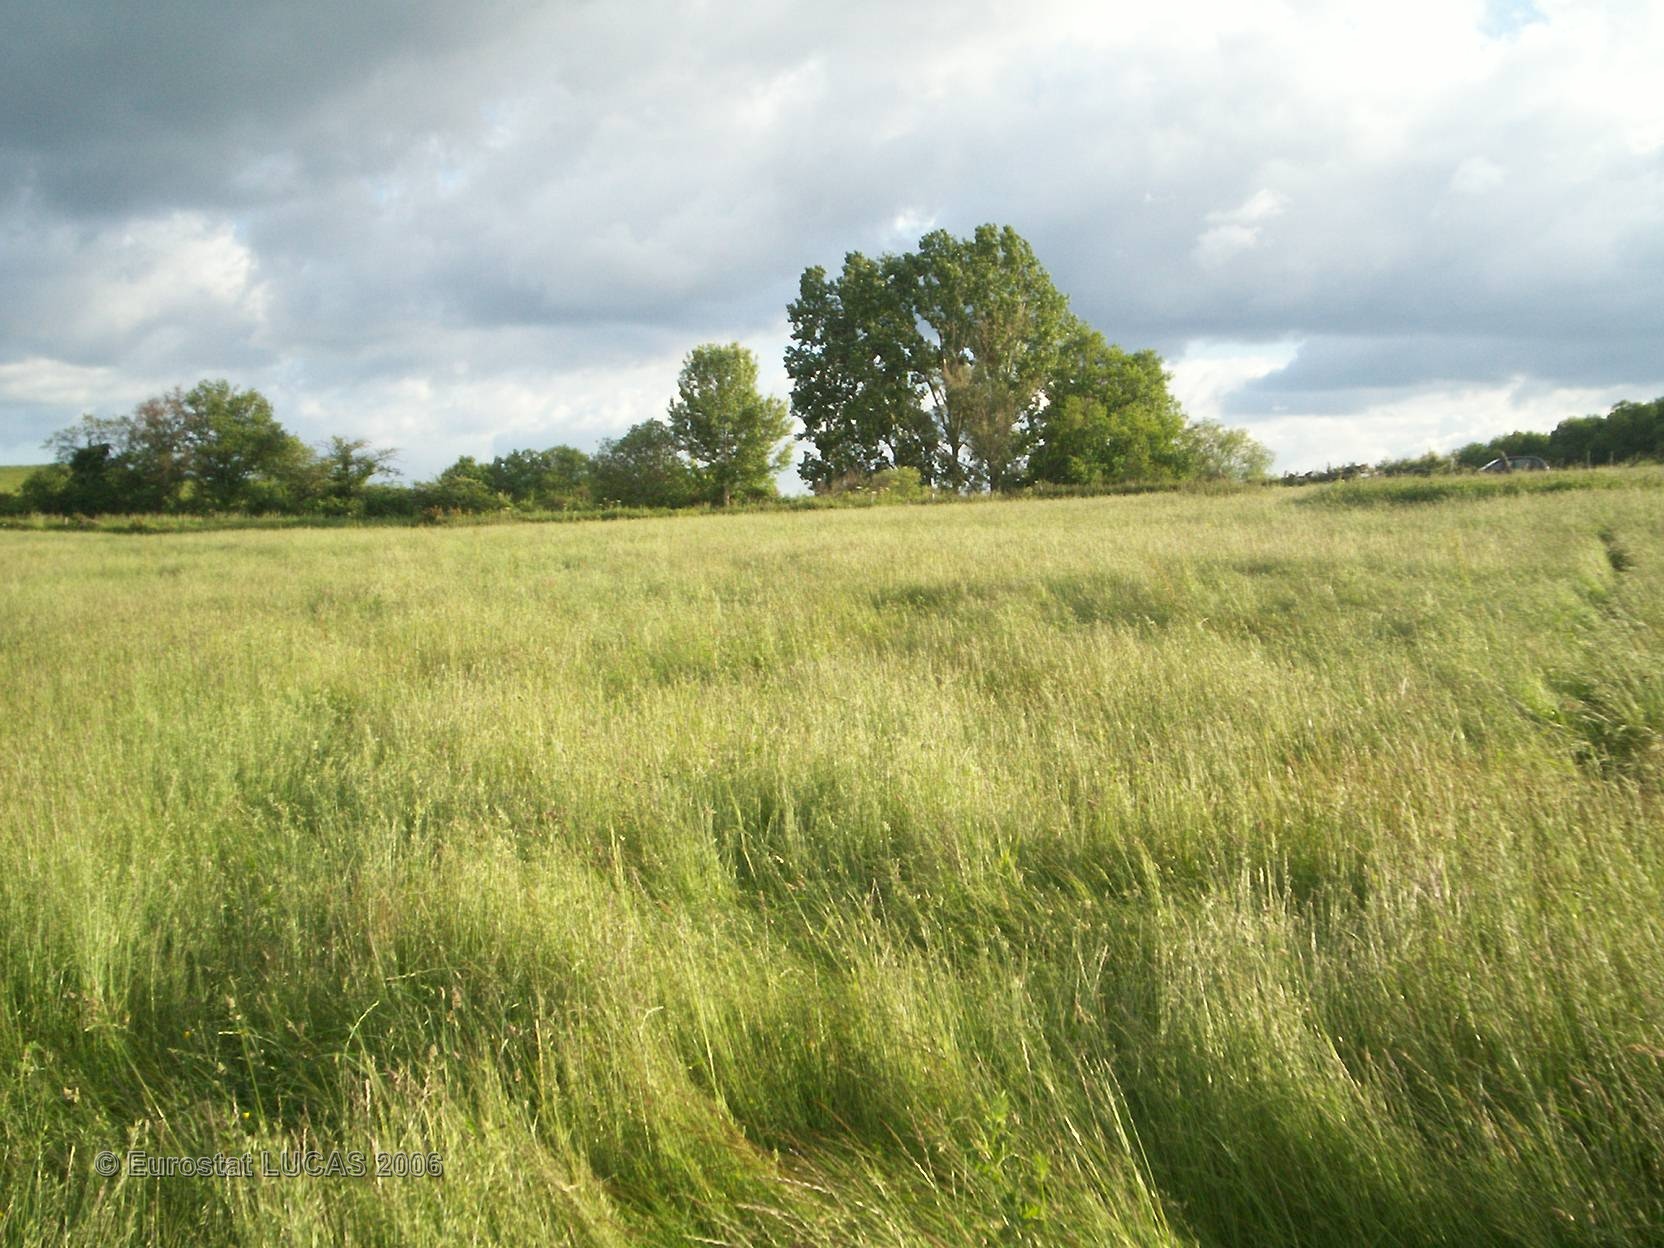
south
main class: Grassland
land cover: Grassland without tree/shrub cover
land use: Agriculture (excluding fallow land and kitchen gardens)
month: June
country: FR
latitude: 46.0958
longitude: 3.1564
